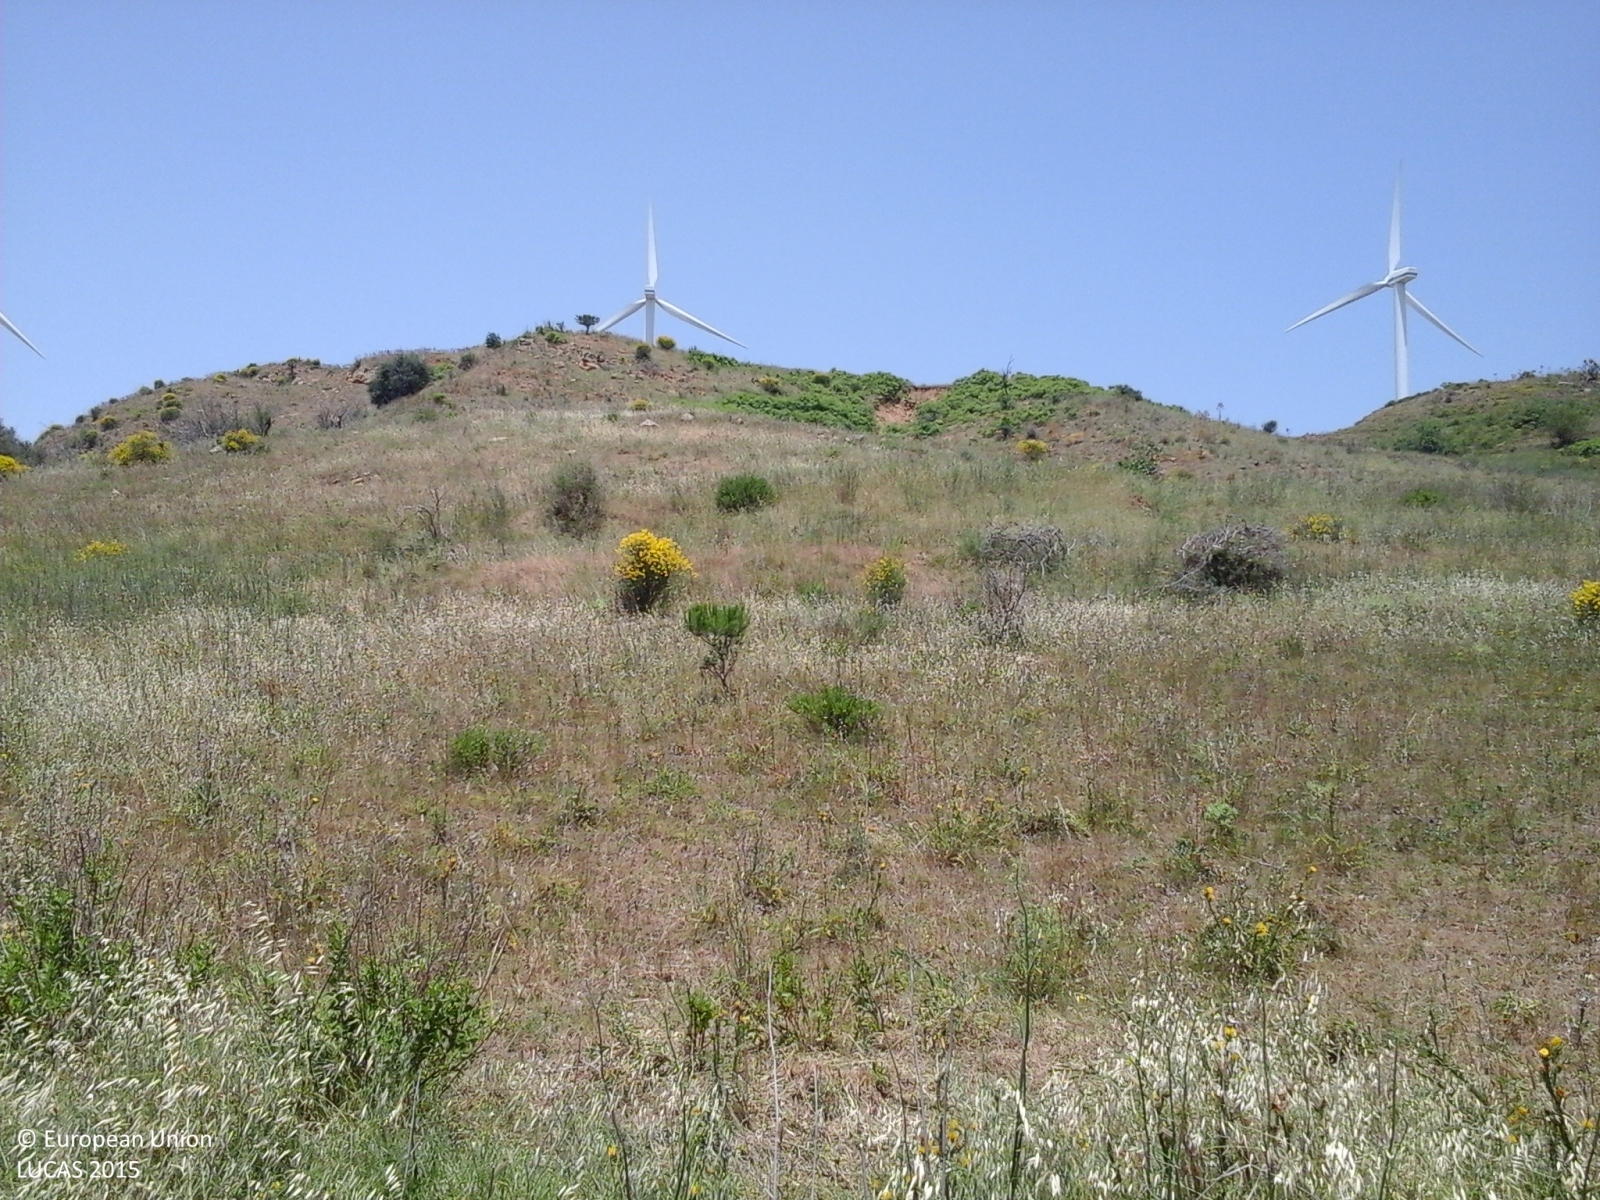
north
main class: Grassland
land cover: Grassland without tree/shrub cover
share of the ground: > 75 %
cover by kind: herbaceous plants 100 %
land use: Agriculture (excluding fallow land and kitchen gardens)
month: June
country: IT
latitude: 37.7643
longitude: 13.7528
